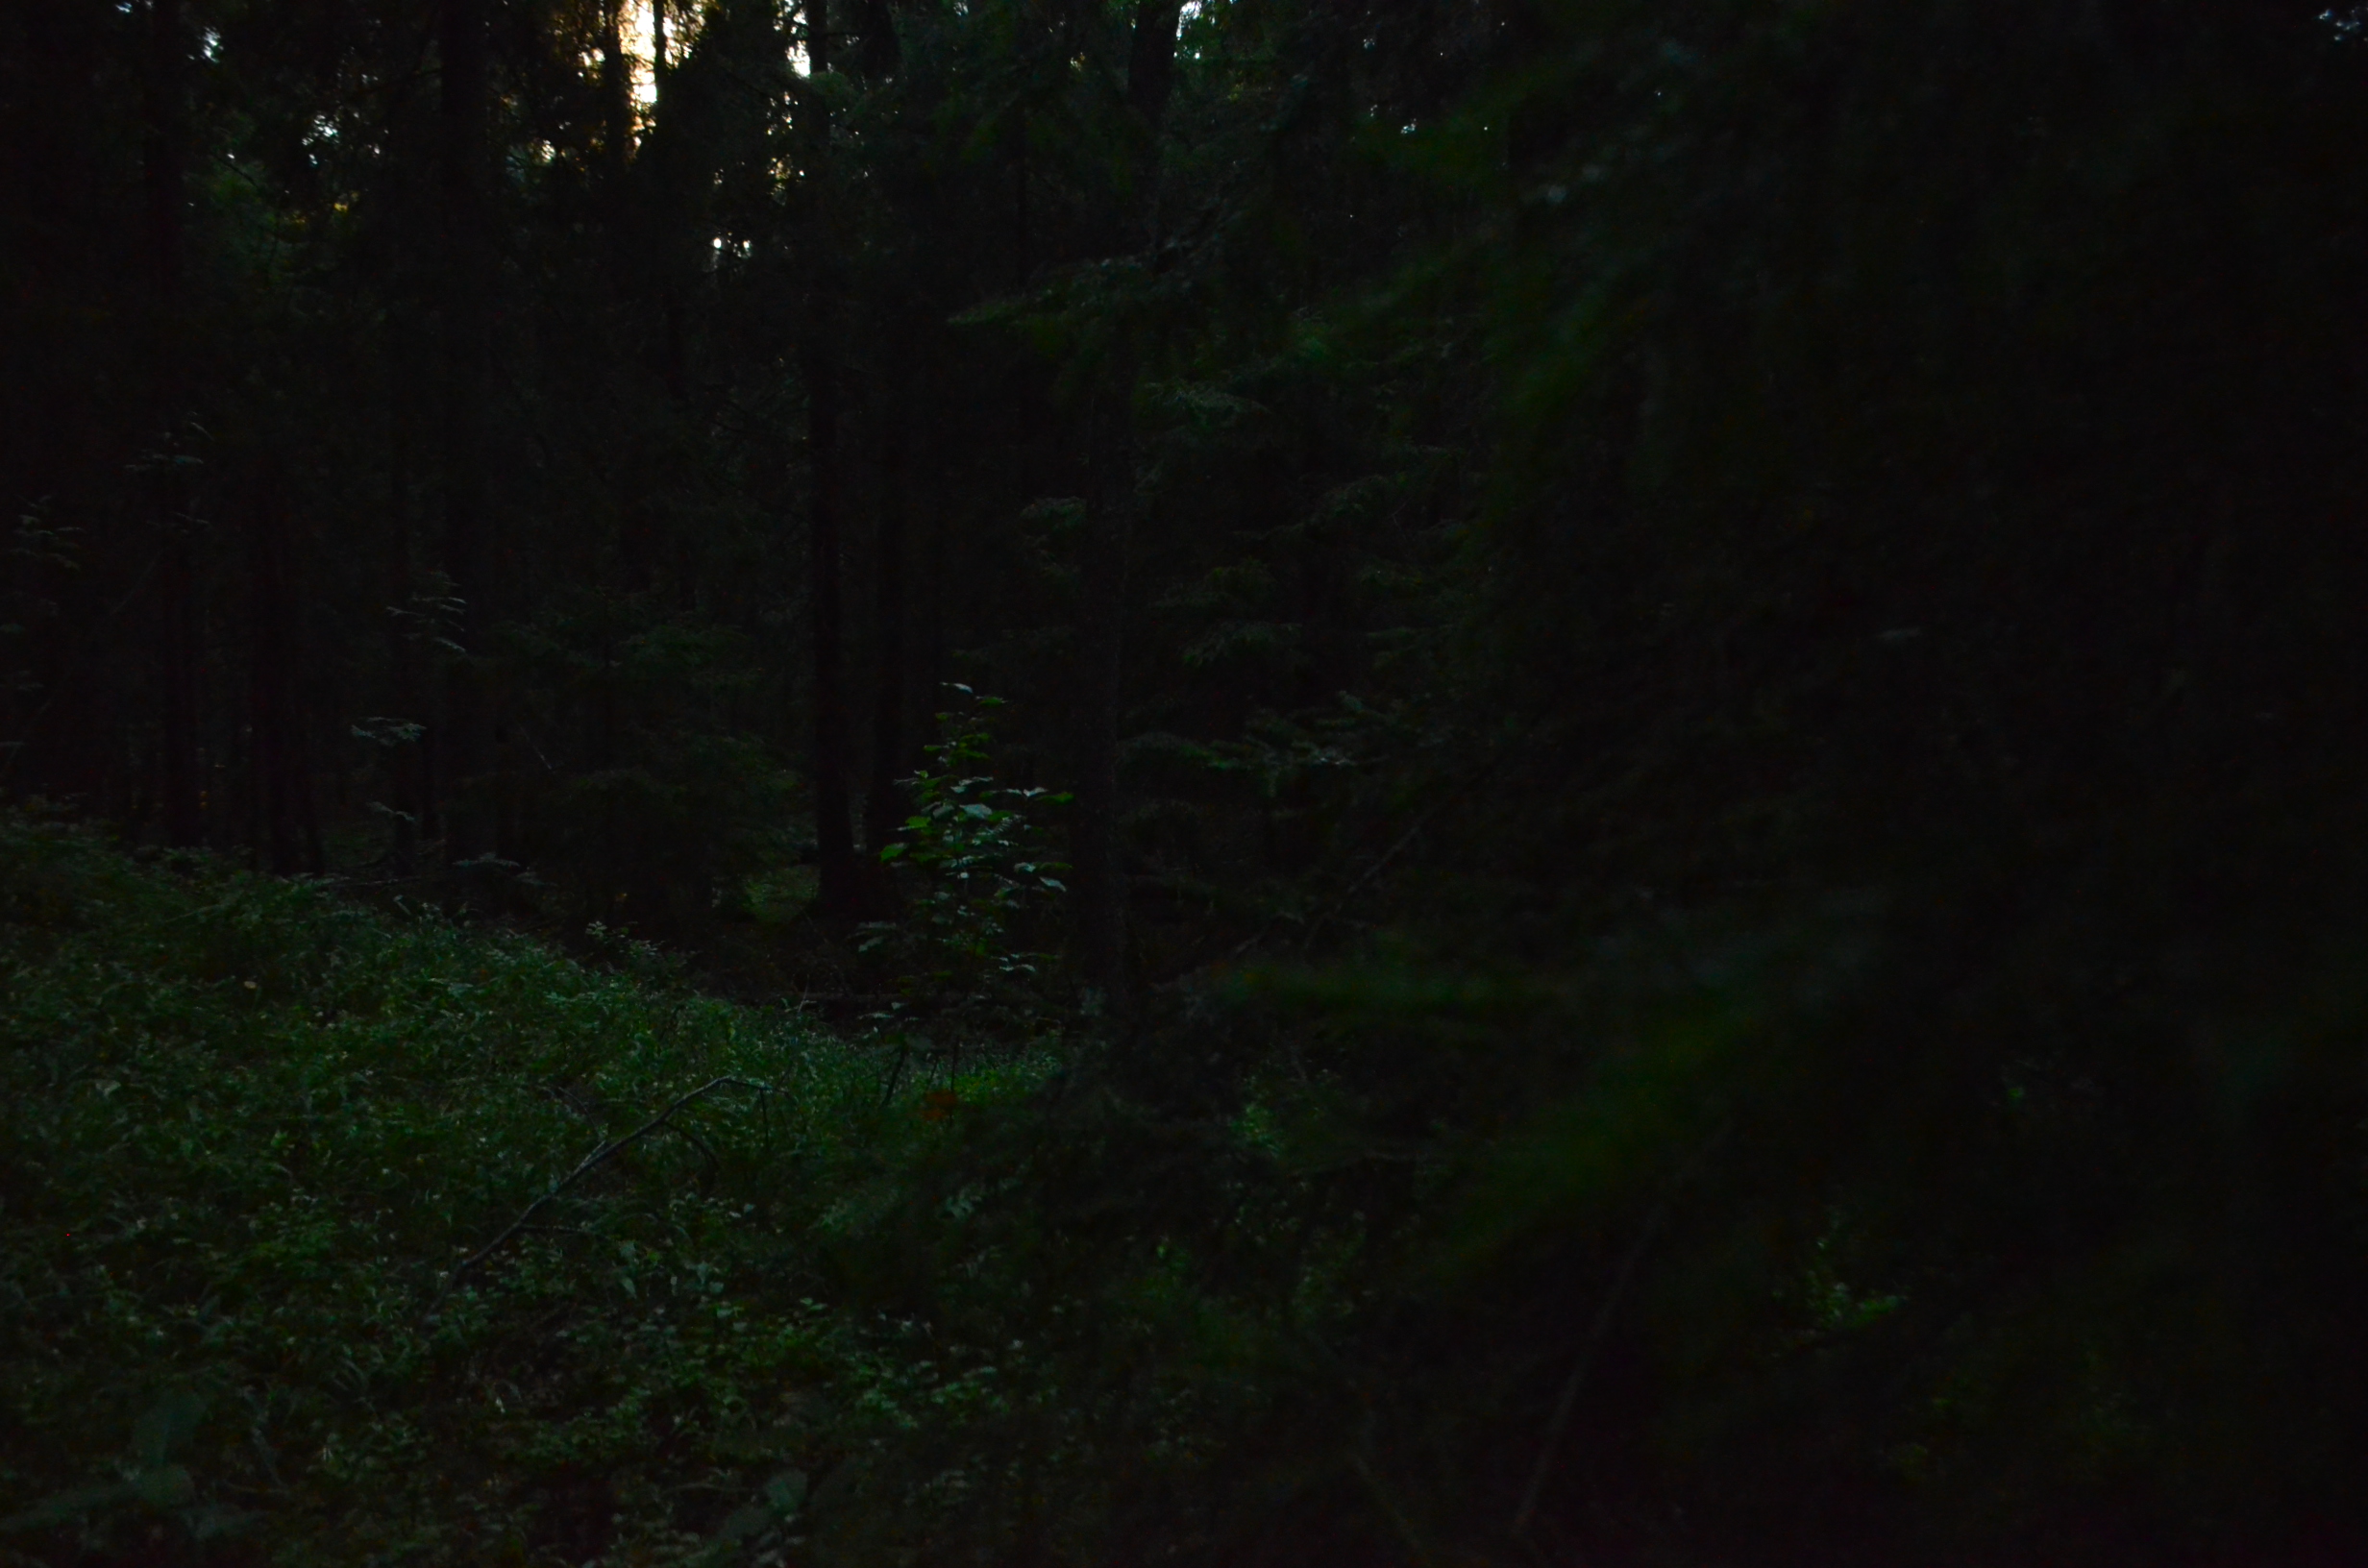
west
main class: Woodland
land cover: Other mixed woodland
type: hemiboreal forest and nemoral coniferous forest and mixed broadleaved-coniferous forest
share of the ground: > 75 %
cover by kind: coniferous forest trees 40 %, broadleaved forest trees 40 %, shrubs 10 %, herbaceous plants 10 %
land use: Forestry
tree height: > 5 m
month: August
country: LV
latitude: 57.5085
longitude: 21.6740
